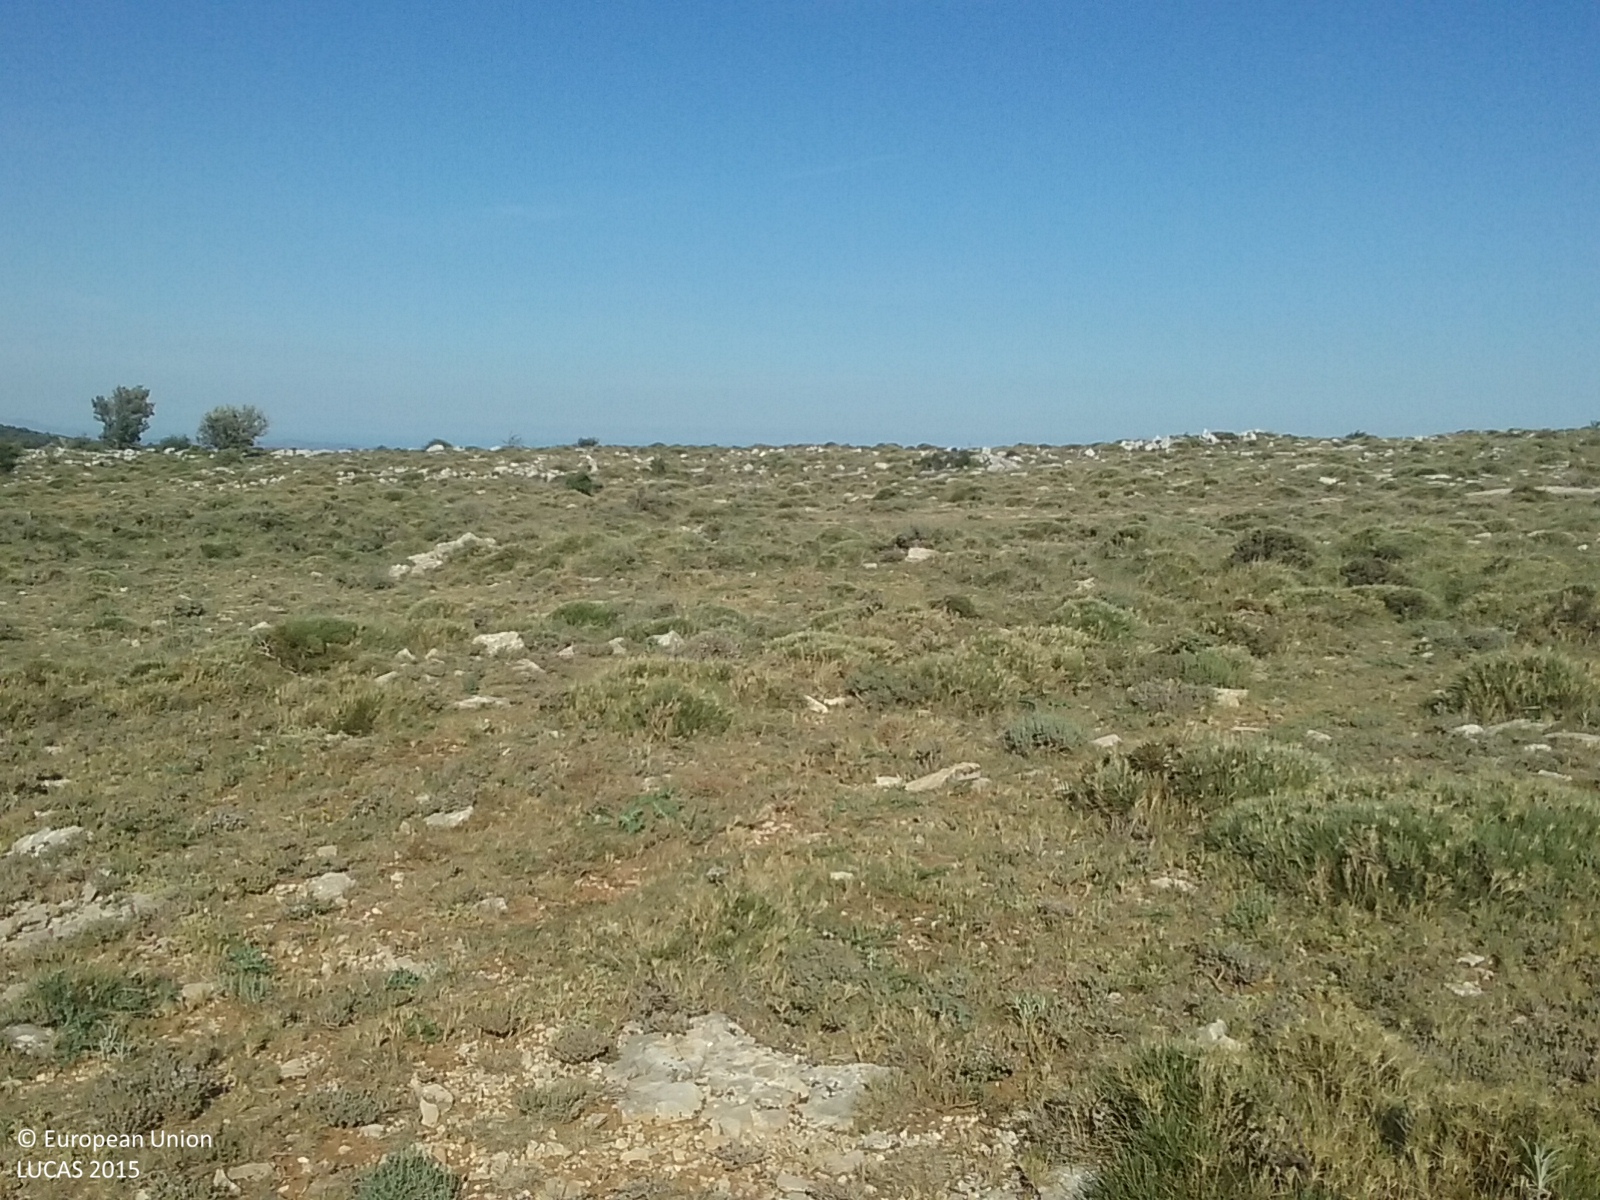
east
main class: Shrubland
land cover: Shrubland without tree cover
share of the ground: > 75 %
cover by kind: herbaceous plants 60 %, shrubs 30 %
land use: Agriculture (excluding fallow land and kitchen gardens)
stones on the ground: 25 - 50 %
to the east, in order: Shrubland without tree cover; Tracks; Shrubland without tree cover; Shrubland with sparse tree cover; Shrubland without tree cover; Shrubland with sparse tree cover; Rock outcrops; Shrubland with sparse tree cover
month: May
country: ES
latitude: 40.4231
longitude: -0.0590
